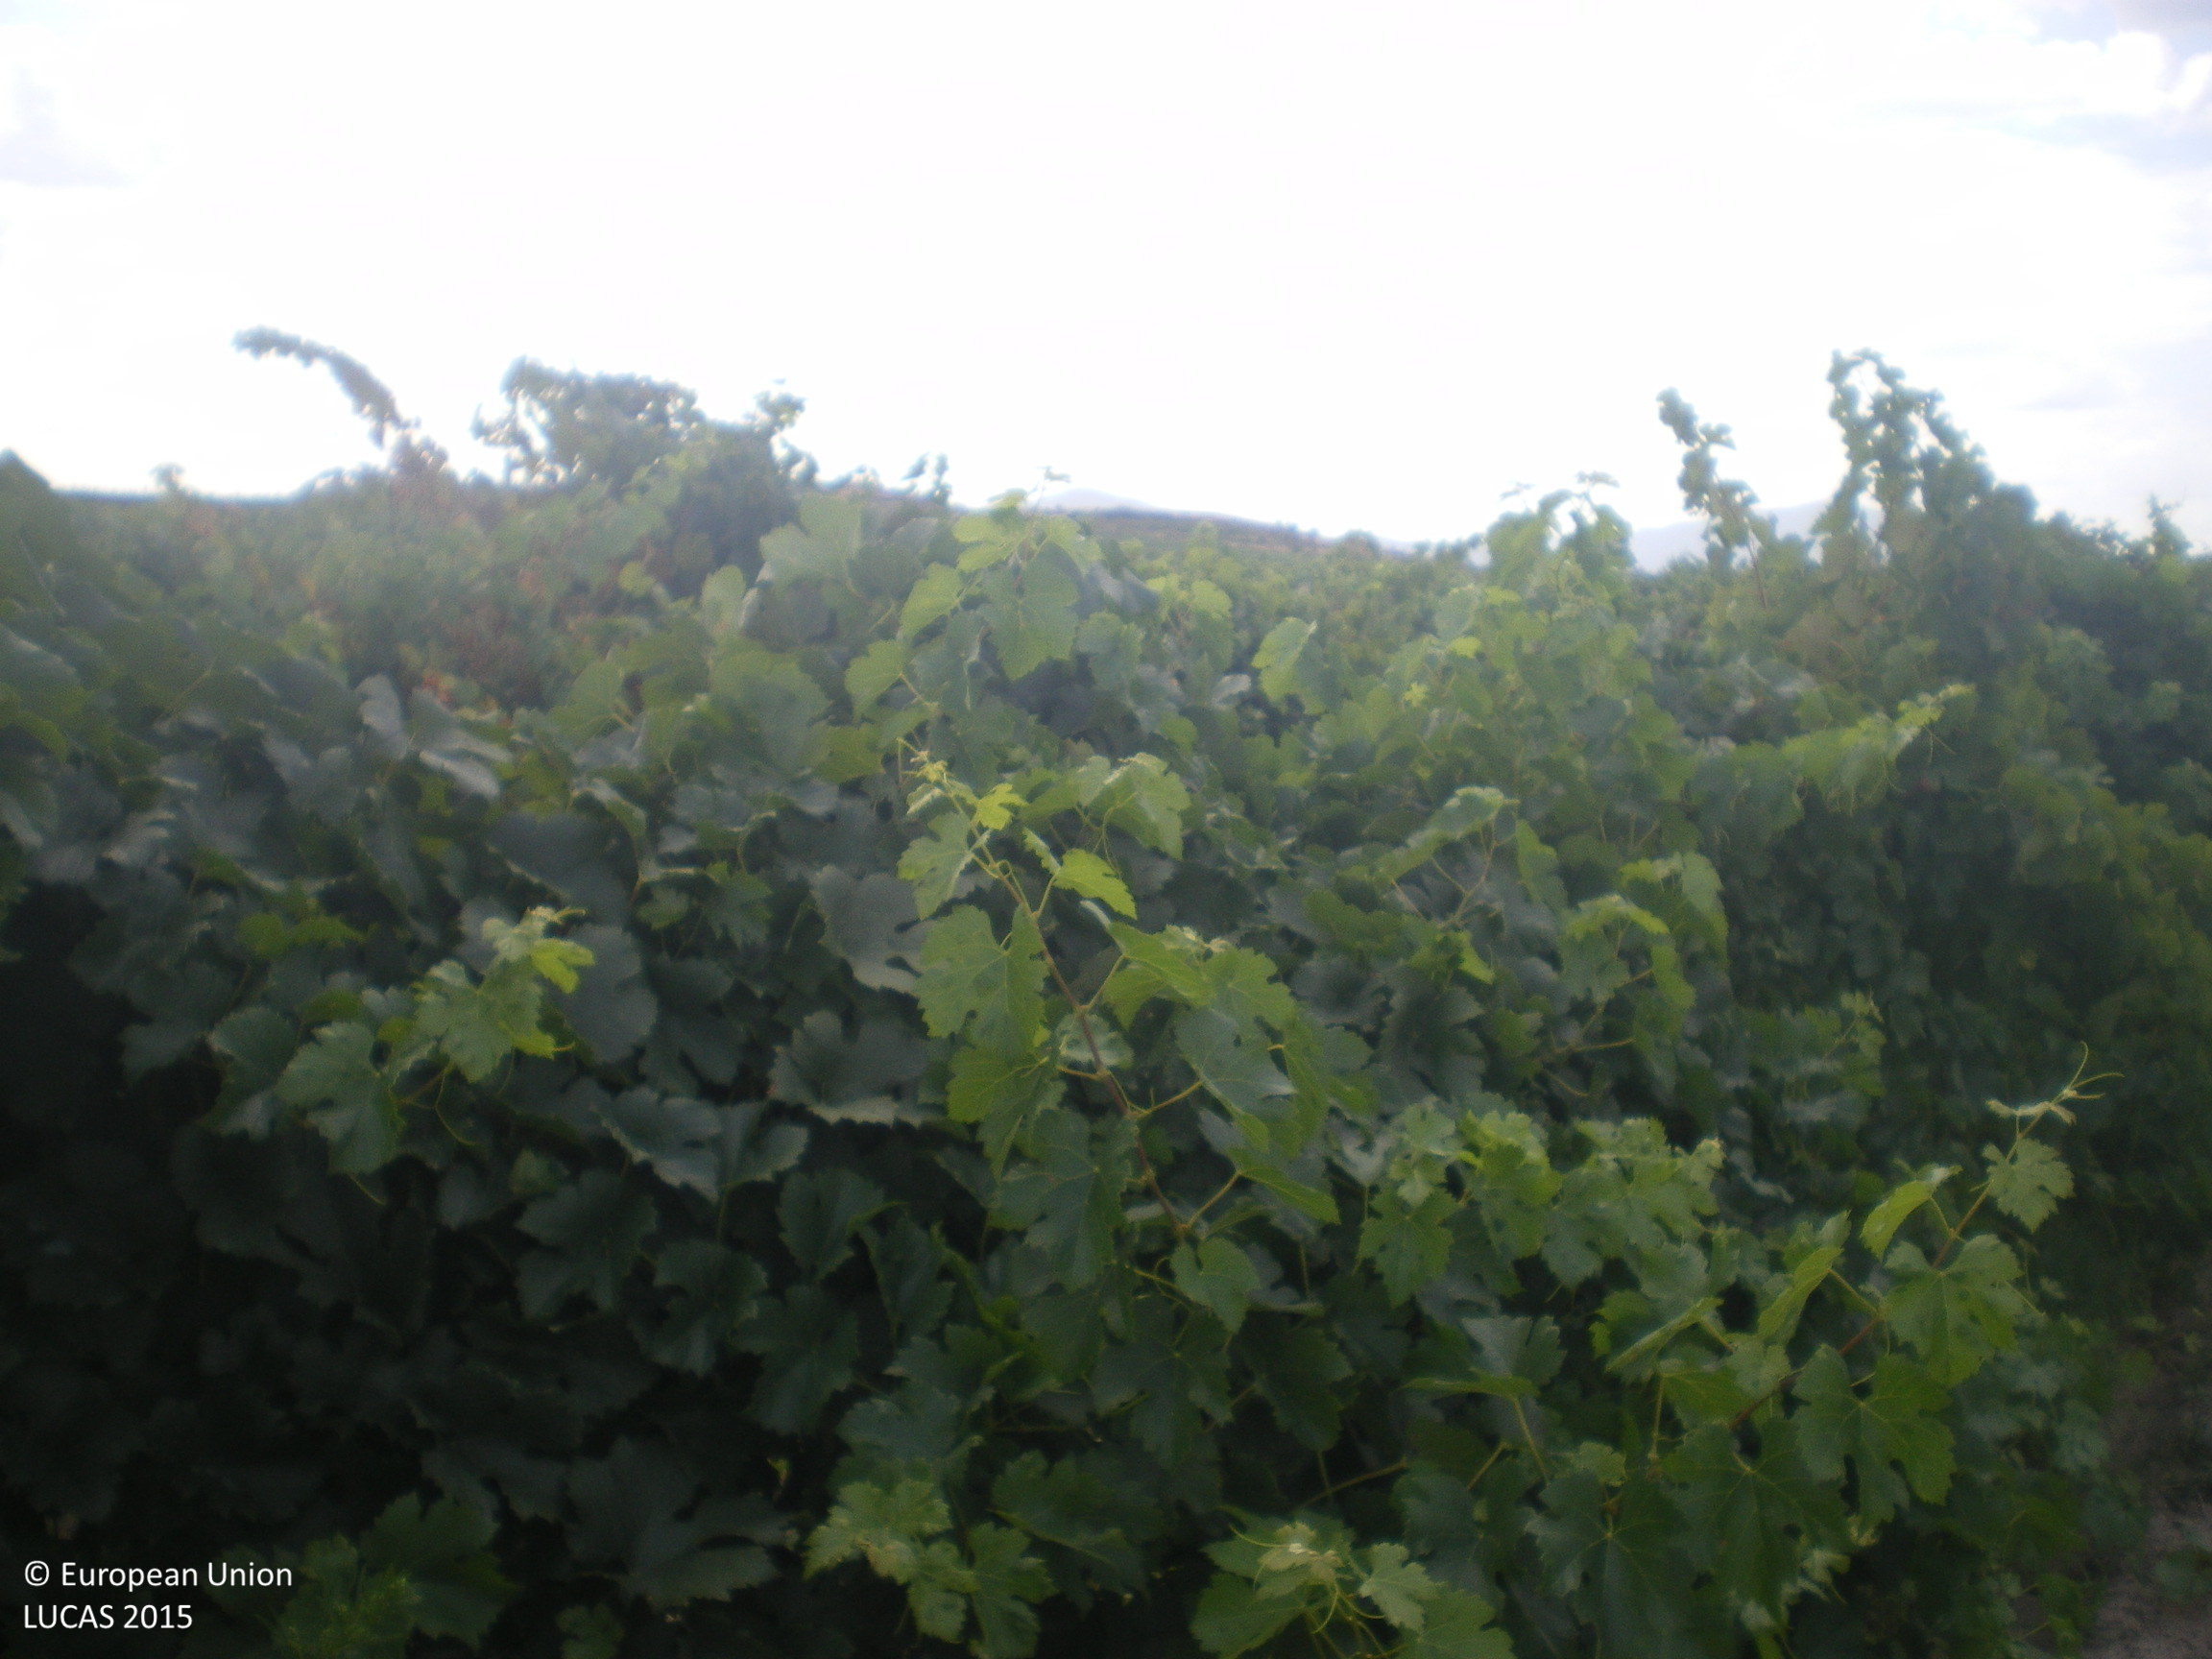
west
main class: Cropland
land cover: Vineyards
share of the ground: 50 - 75 %
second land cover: Other bare soil
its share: > 75 %
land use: Agriculture (excluding fallow land and kitchen gardens)
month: August
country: BG
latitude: 42.6105
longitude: 25.8404
